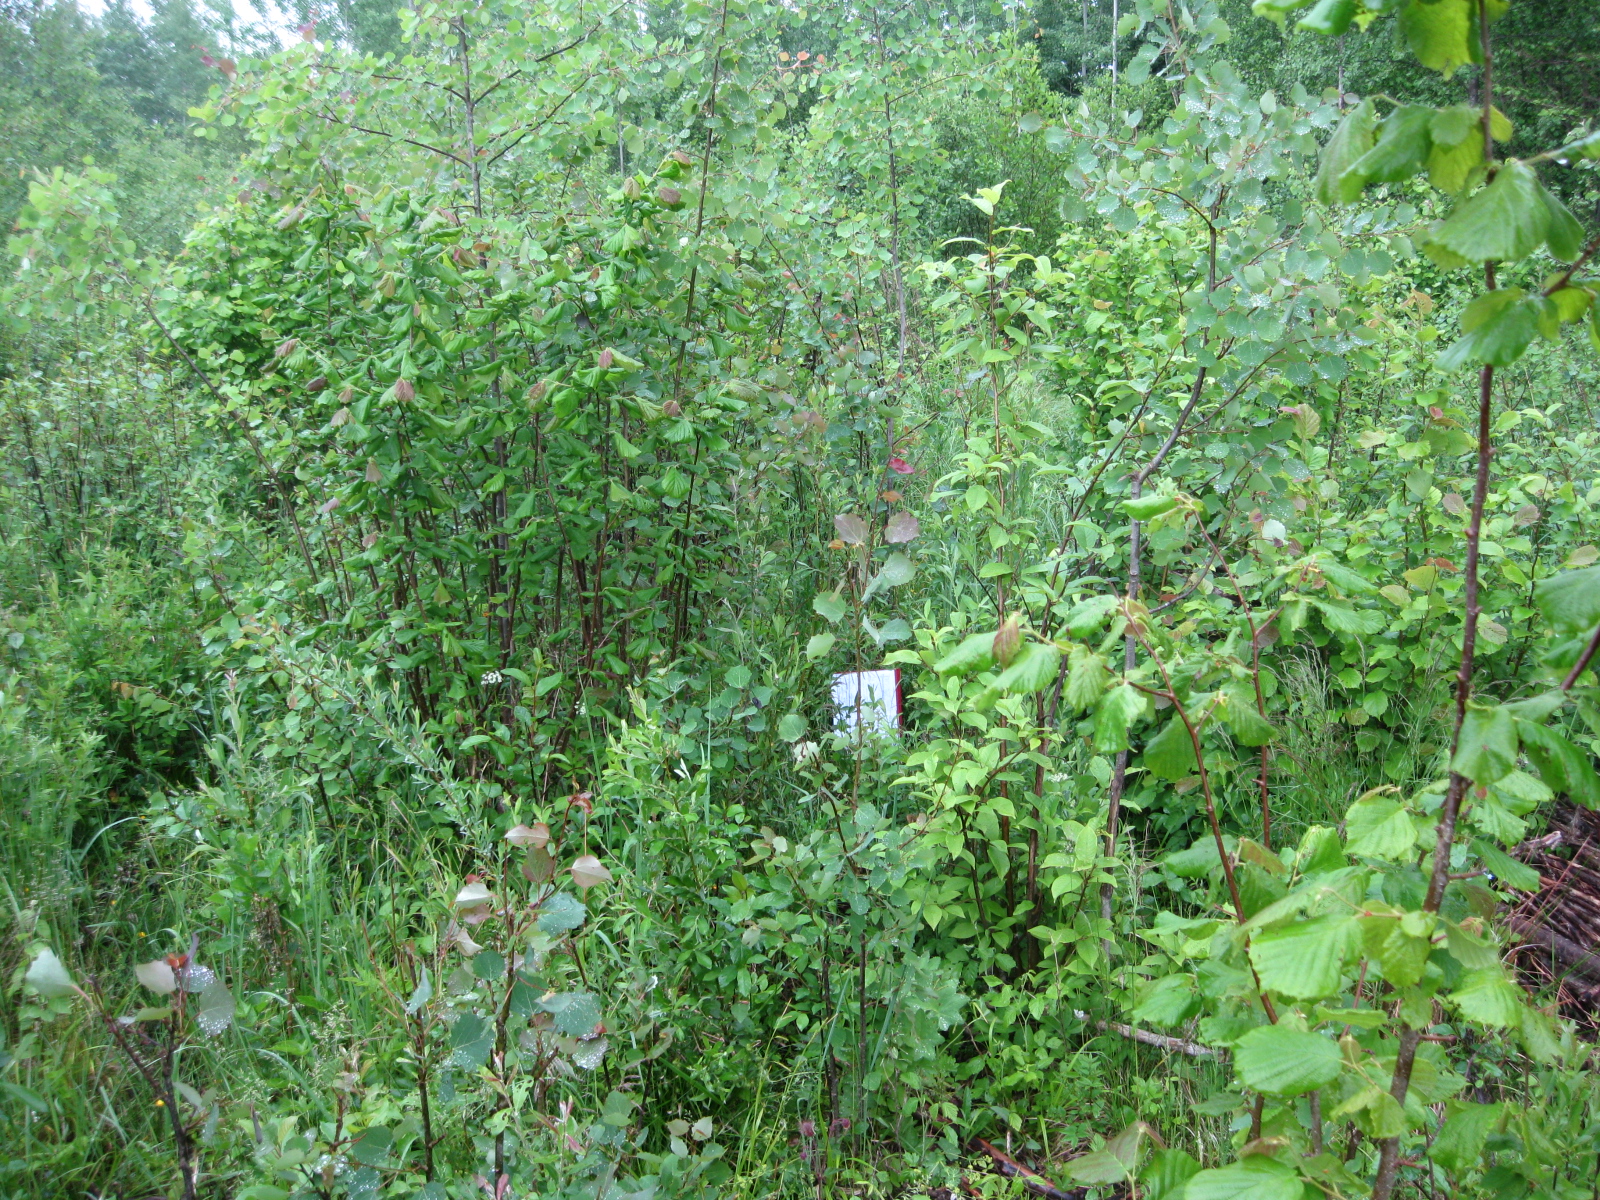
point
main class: Woodland
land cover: Broadleaved woodland
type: non-riverine alder, birch or aspen forest
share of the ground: > 75 %
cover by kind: broadleaved forest trees 80 %, herbaceous plants 15 %, shrubs 5 %
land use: Forestry
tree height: < 5 m
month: June
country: LT
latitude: 55.6532
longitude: 23.9945
